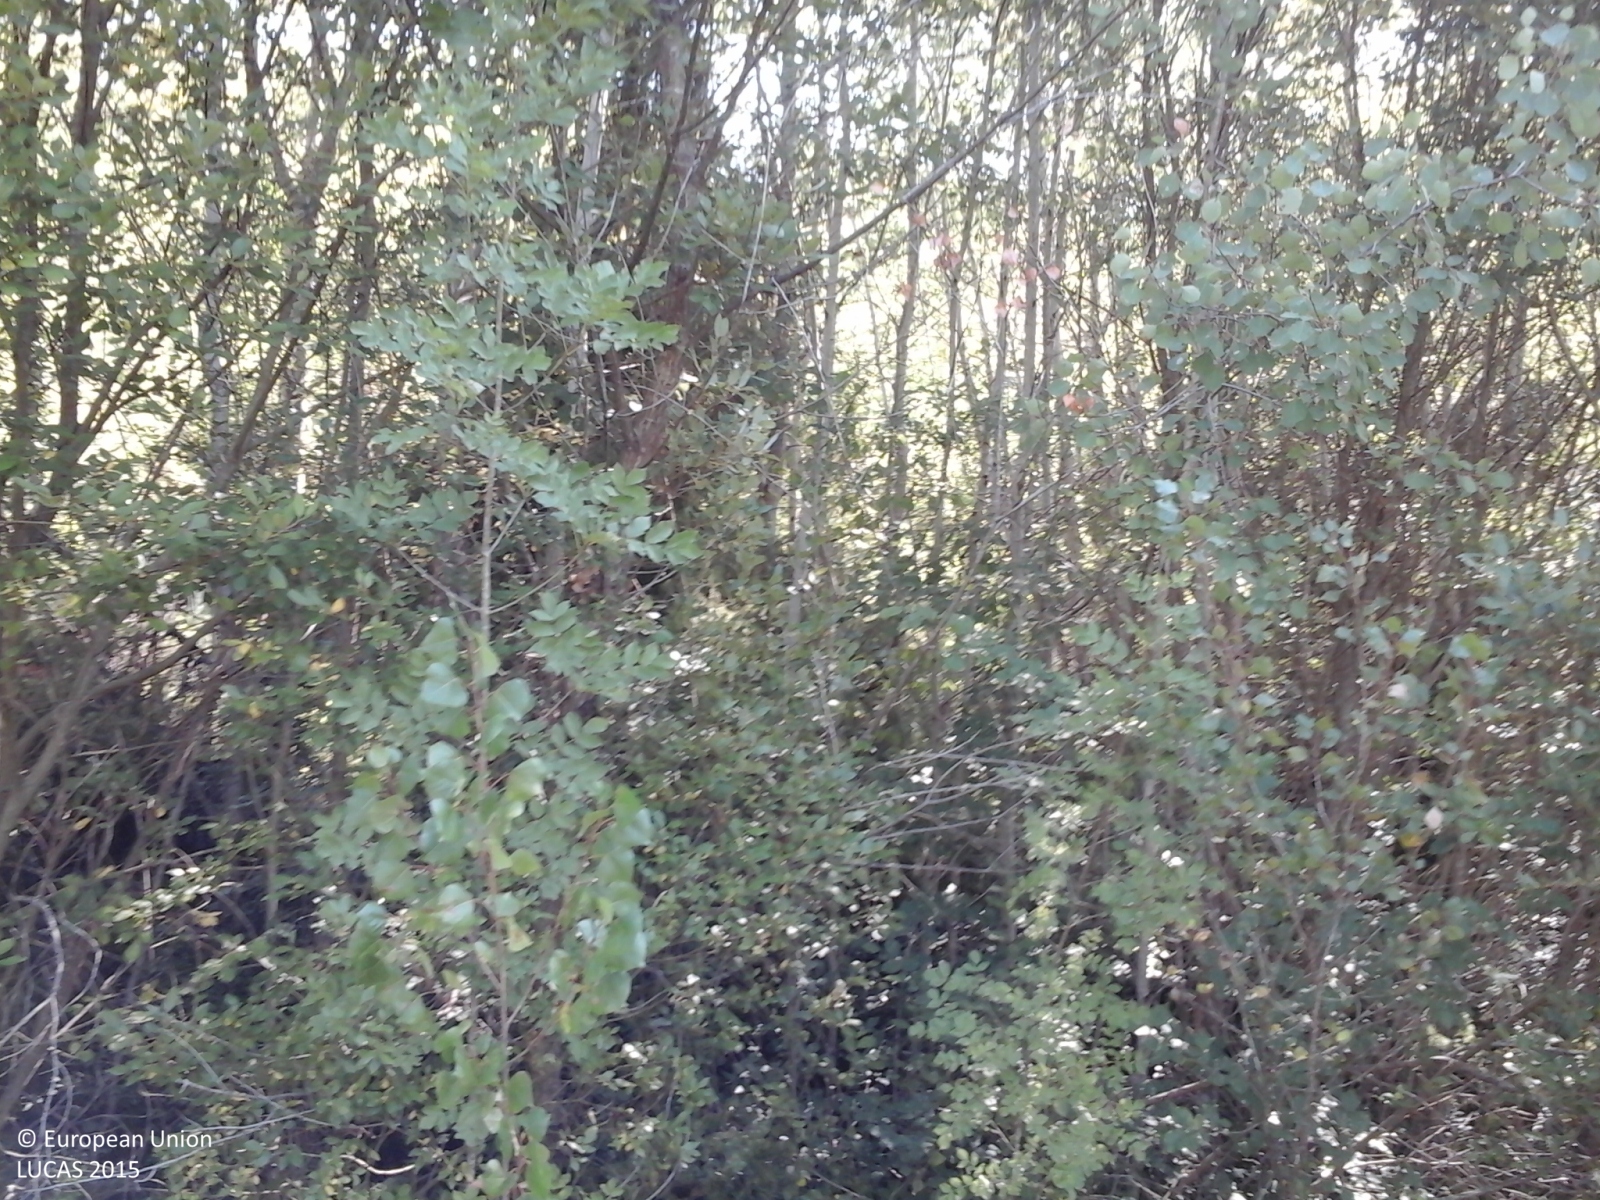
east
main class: Woodland
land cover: Broadleaved woodland
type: thermophilous deciduous forest
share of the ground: > 75 %
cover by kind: broadleaved forest trees 90 %, shrubs 5 %, herbaceous plants 5 %
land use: Semi-natural and natural areas not in use
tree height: > 5 m
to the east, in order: Broadleaved woodland; Tracks; Broadleaved woodland
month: September
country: IT
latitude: 41.6795
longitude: 14.2256
